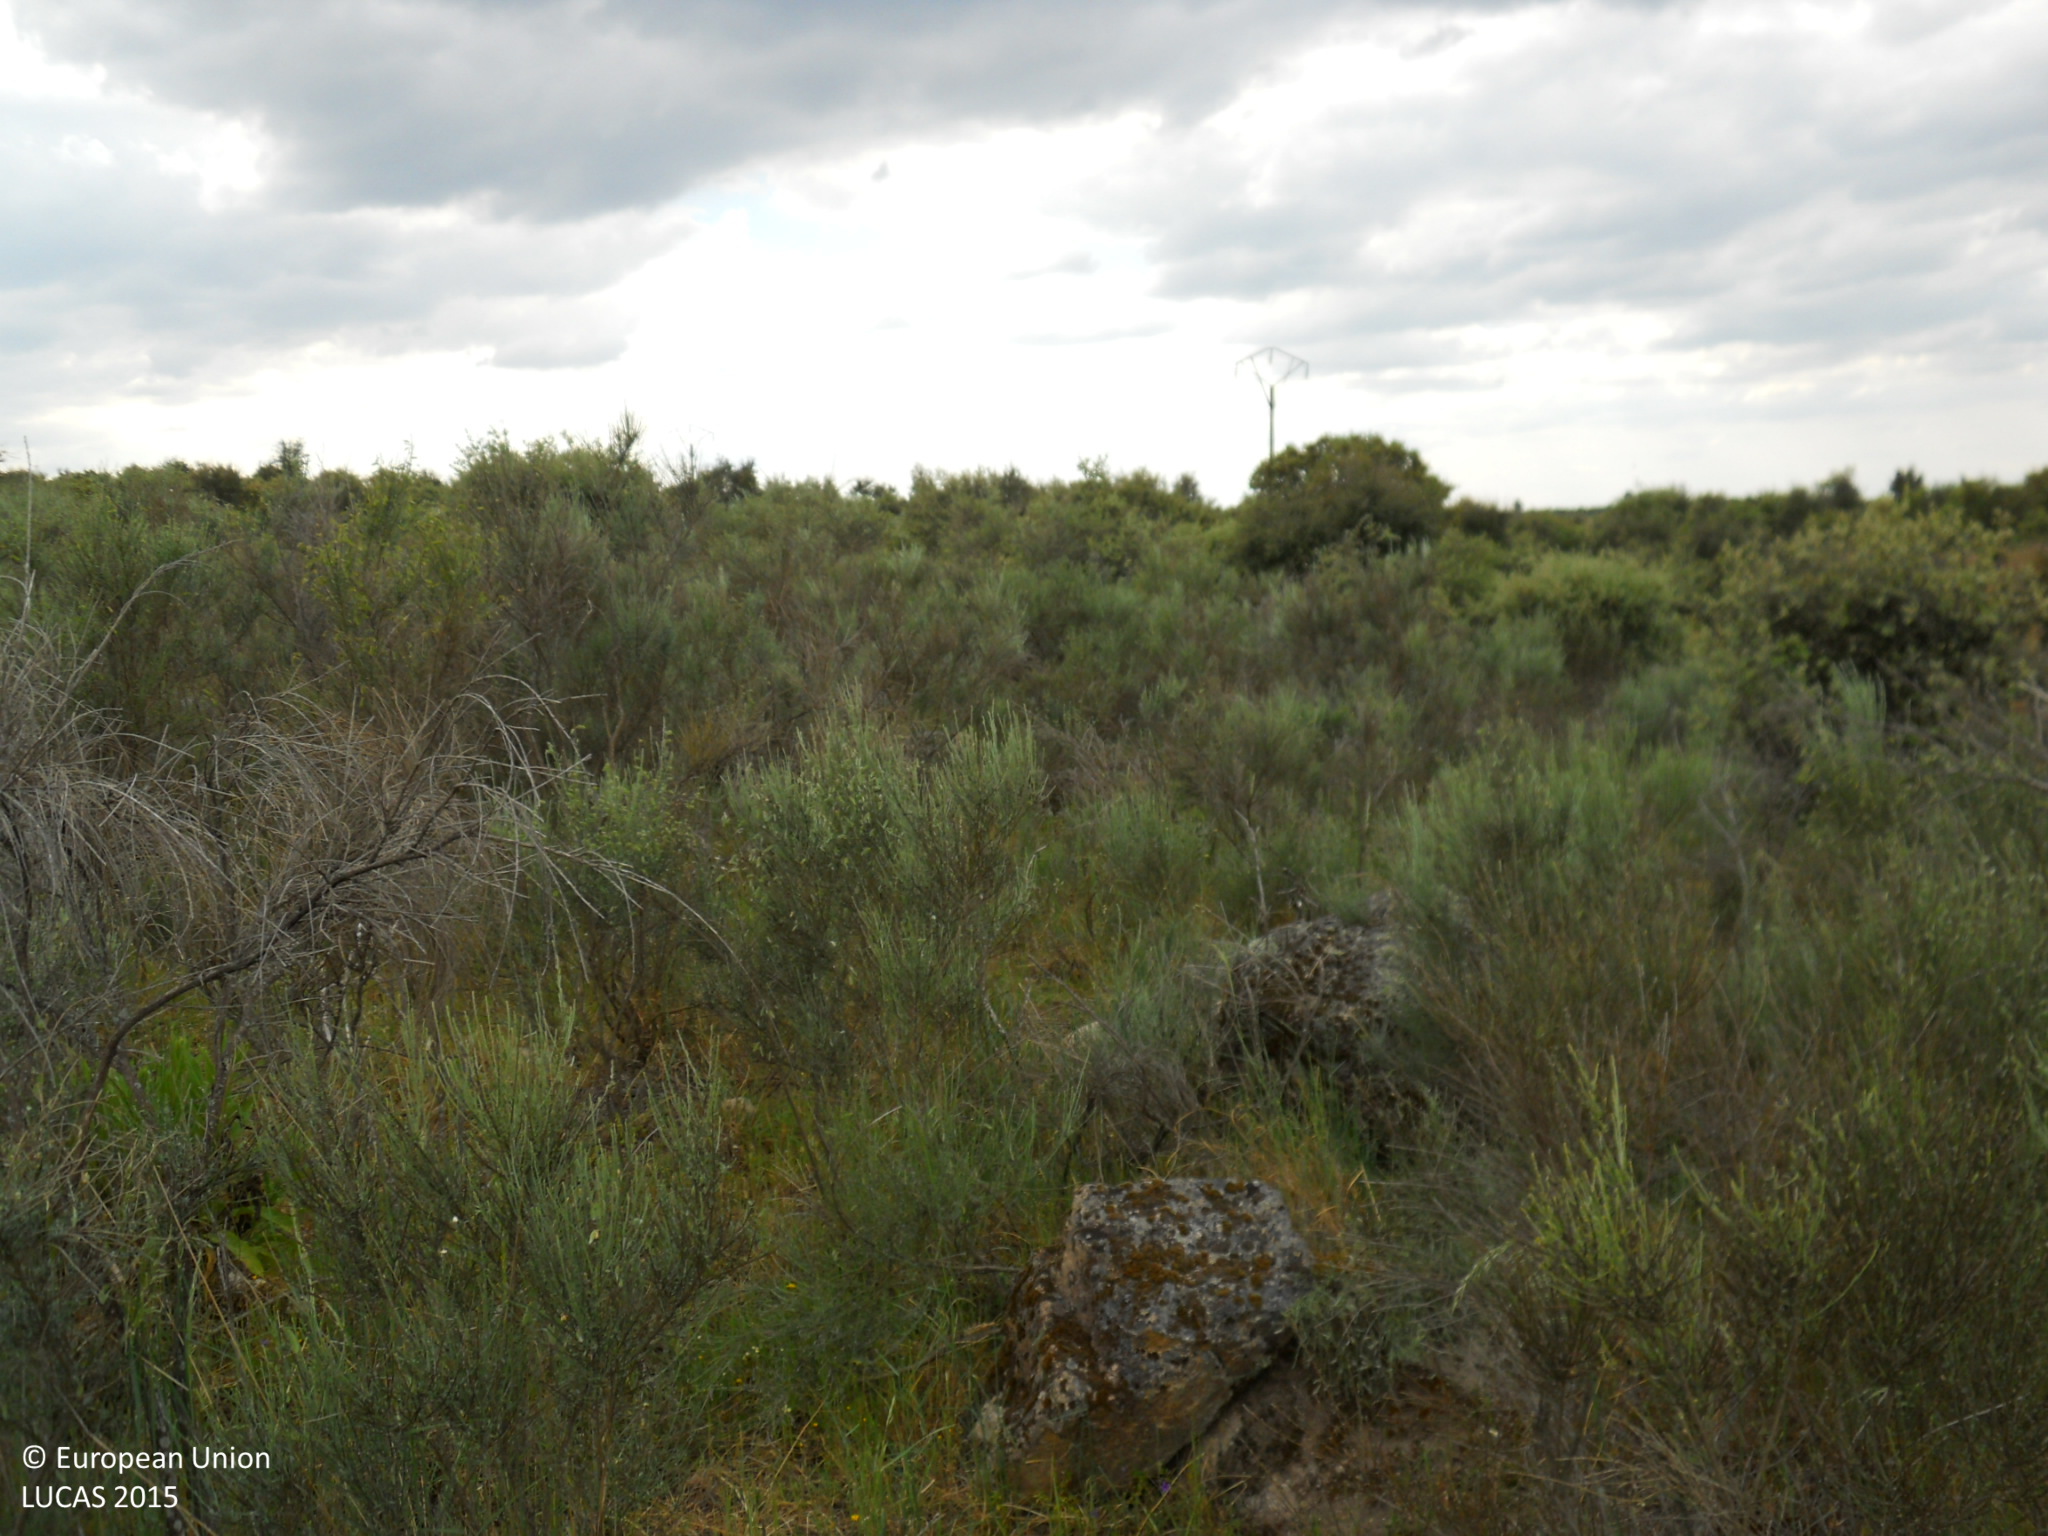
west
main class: Shrubland
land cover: Shrubland with sparse tree cover
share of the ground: > 75 %
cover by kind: shrubs 95 %, broadleaved forest trees 5 %
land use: Forestry
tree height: < 5 m
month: April
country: ES
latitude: 39.2698
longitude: -6.8936
